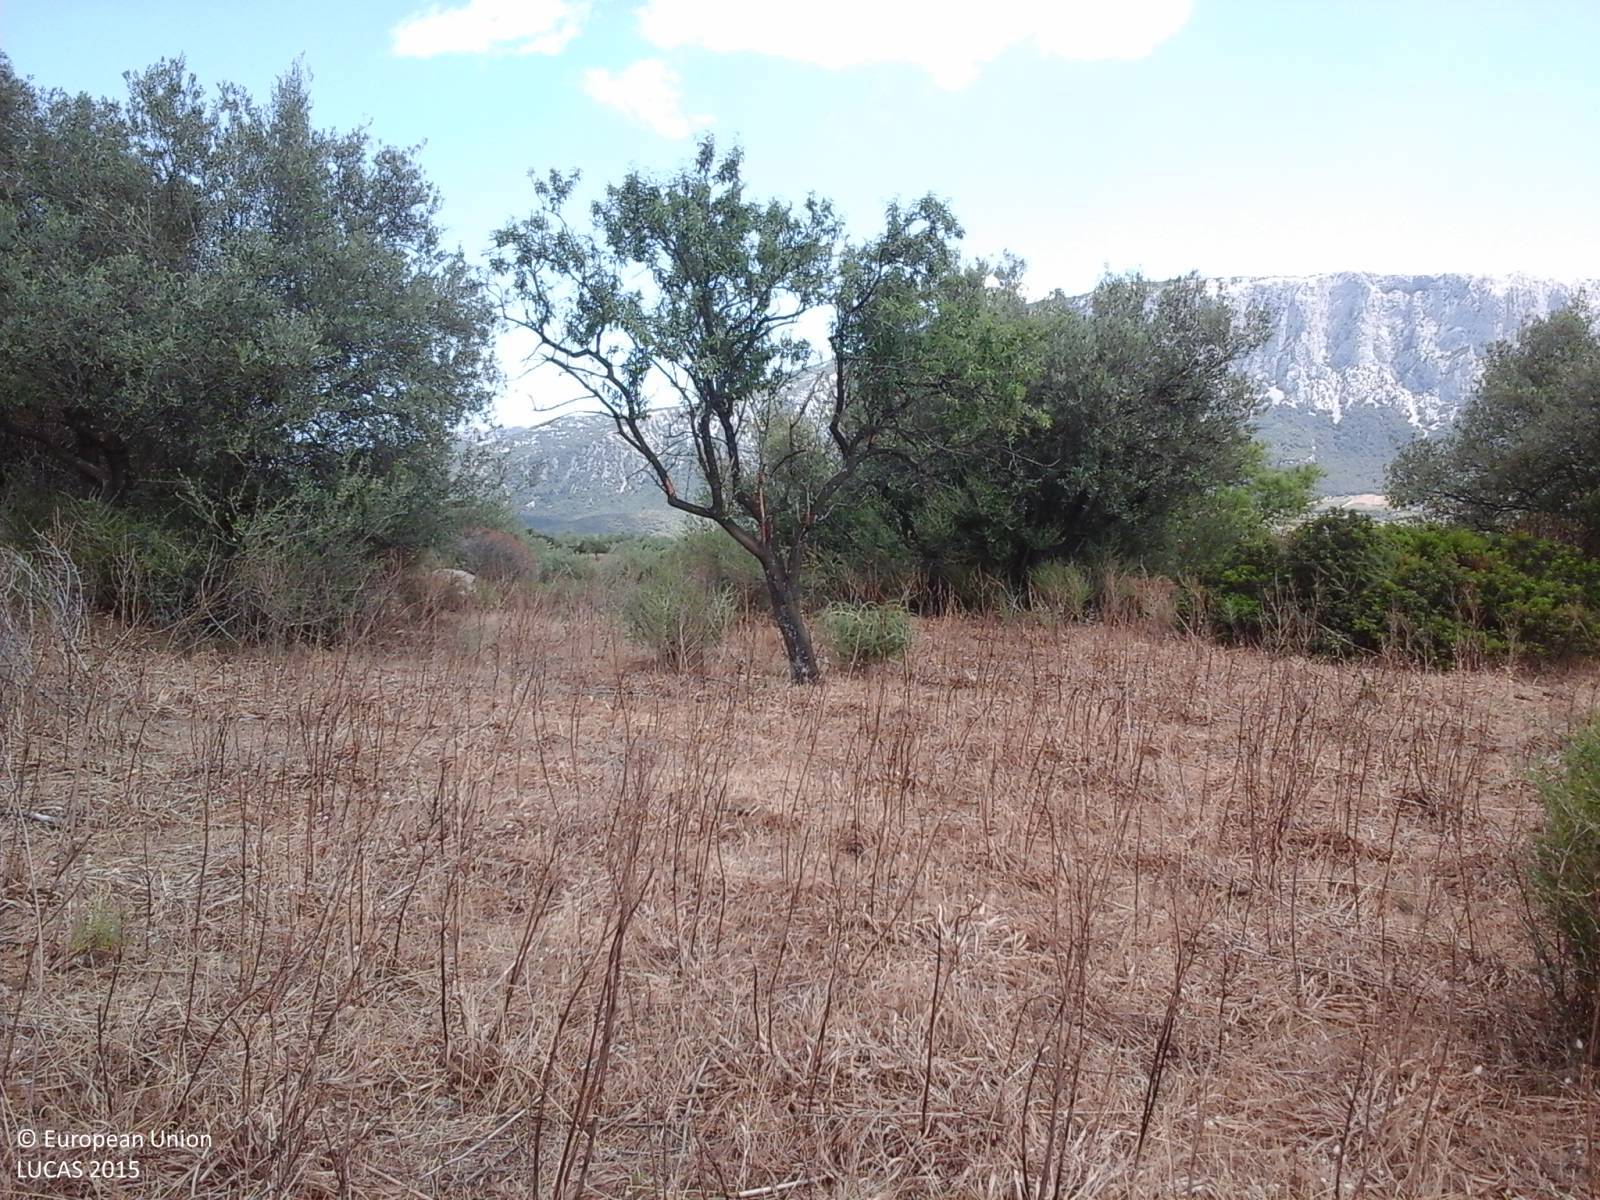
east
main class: Cropland
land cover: Nuts trees
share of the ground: > 75 %
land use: Agriculture (excluding fallow land and kitchen gardens)
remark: Burnt area
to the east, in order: Nuts trees; Grassland without tree/shrub cover; Broadleaved woodland; Dry stone walls; Tracks; Dry stone walls; Broadleaved woodland; Olive groves; Dry stone walls; Tracks; Dry stone walls; Grassland with sparse tree/shrub cover; Dry stone walls; Olive groves
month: May
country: IT
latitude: 40.3020
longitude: 9.4499
